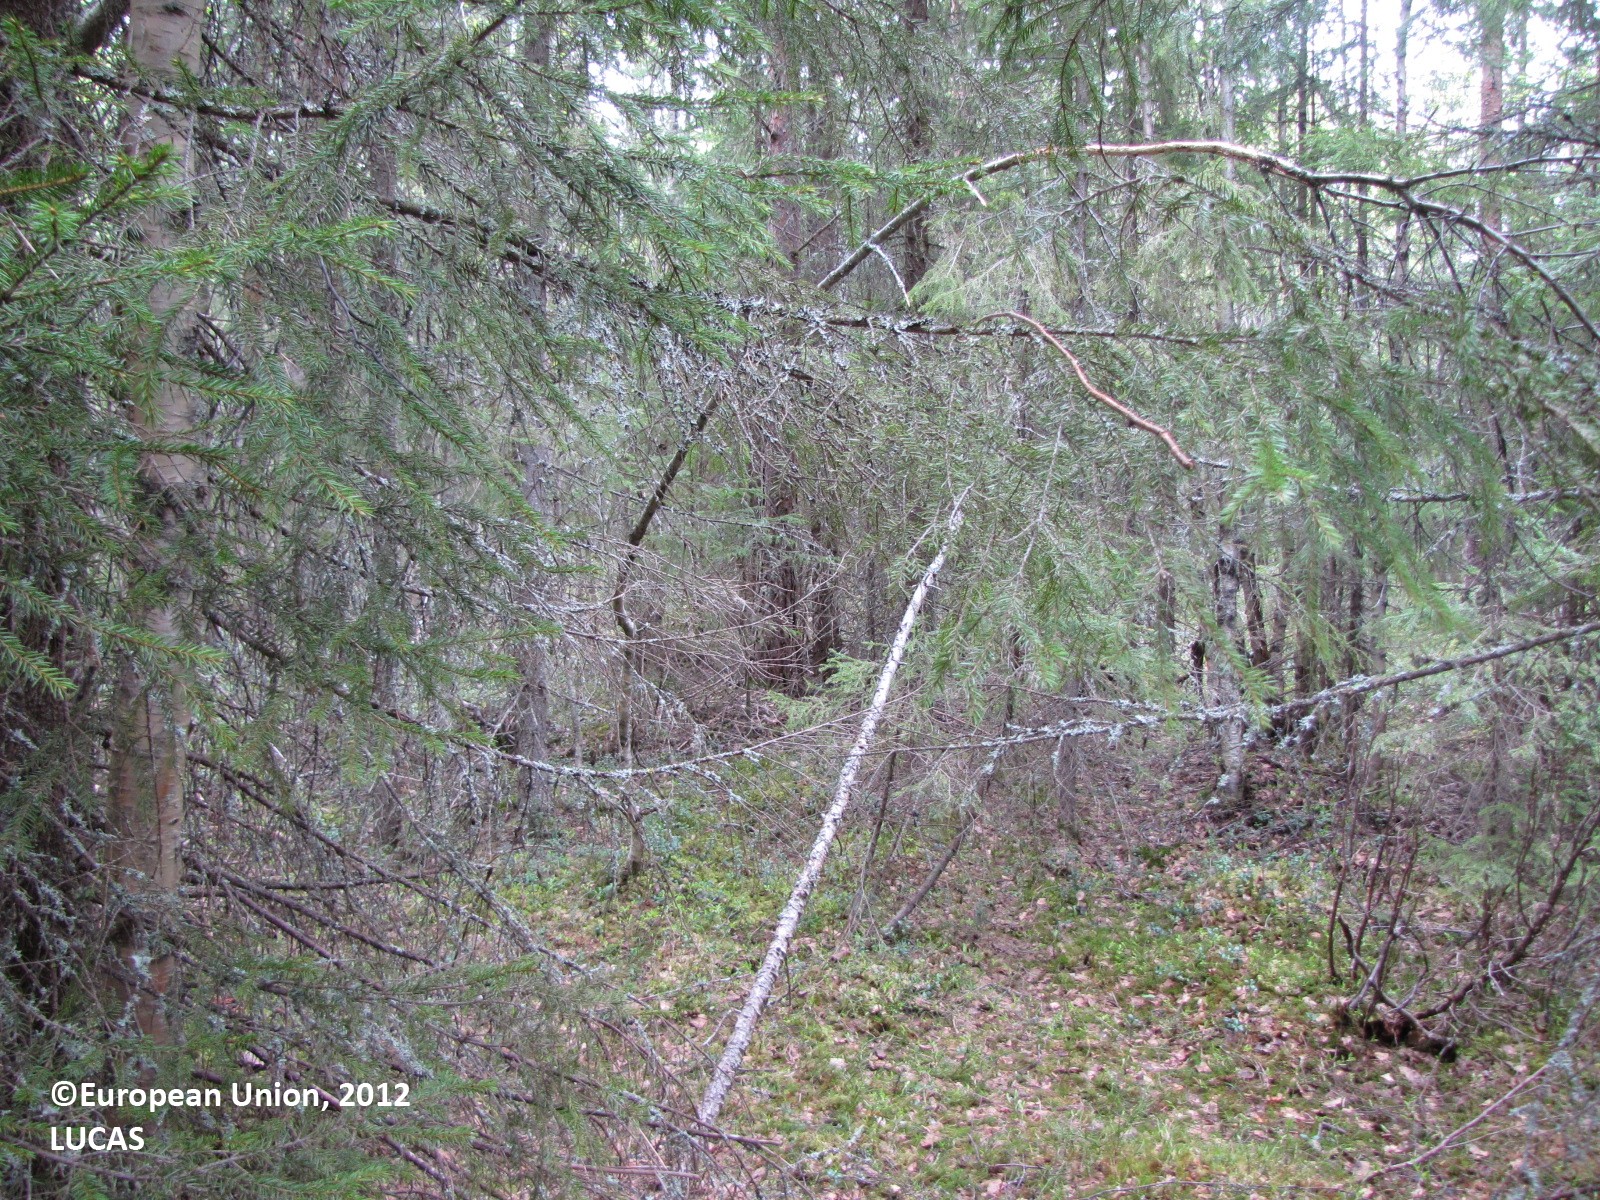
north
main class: Woodland
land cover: Spruce dominated mixed woodland
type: boreal forest
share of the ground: > 75 %
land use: Forestry
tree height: > 5 m
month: June
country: FI
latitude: 65.8110
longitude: 24.5109
